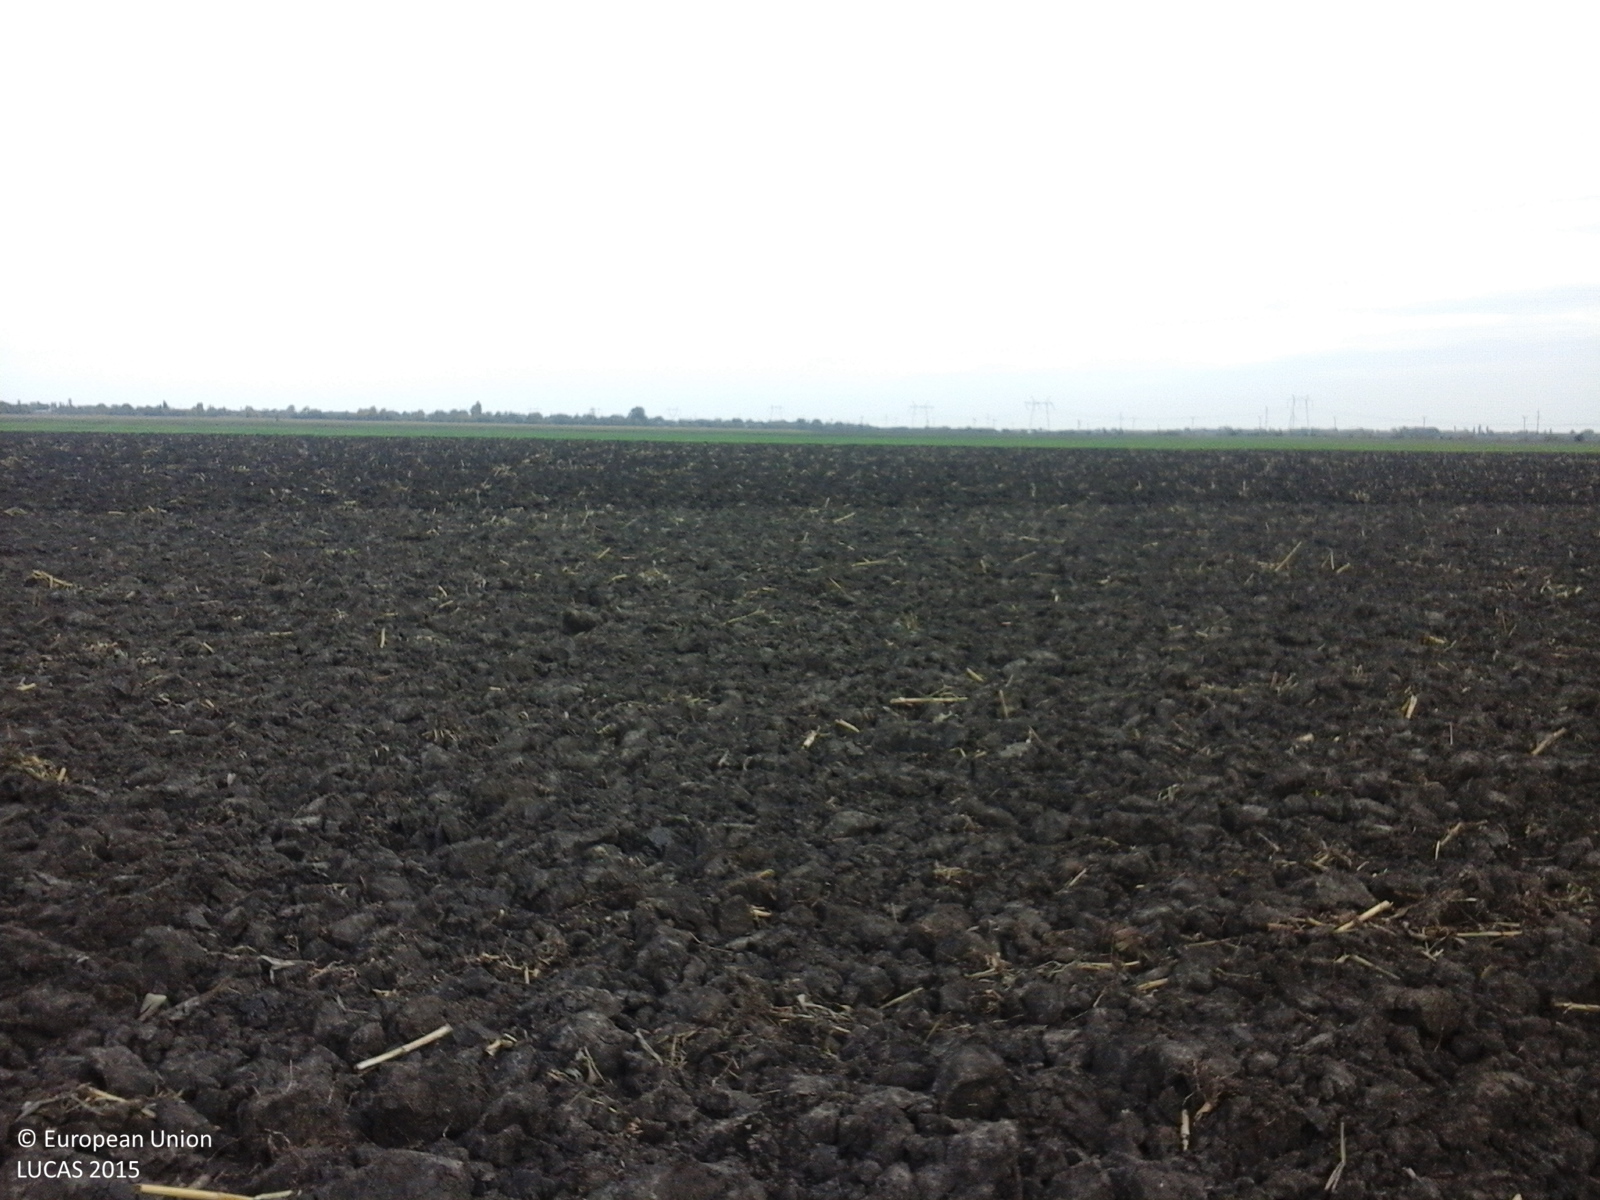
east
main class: Cropland
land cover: Maize
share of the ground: < 10 %
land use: Agriculture (excluding fallow land and kitchen gardens)
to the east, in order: Maize; Common wheat
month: October
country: RO
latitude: 44.9570
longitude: 26.3290
